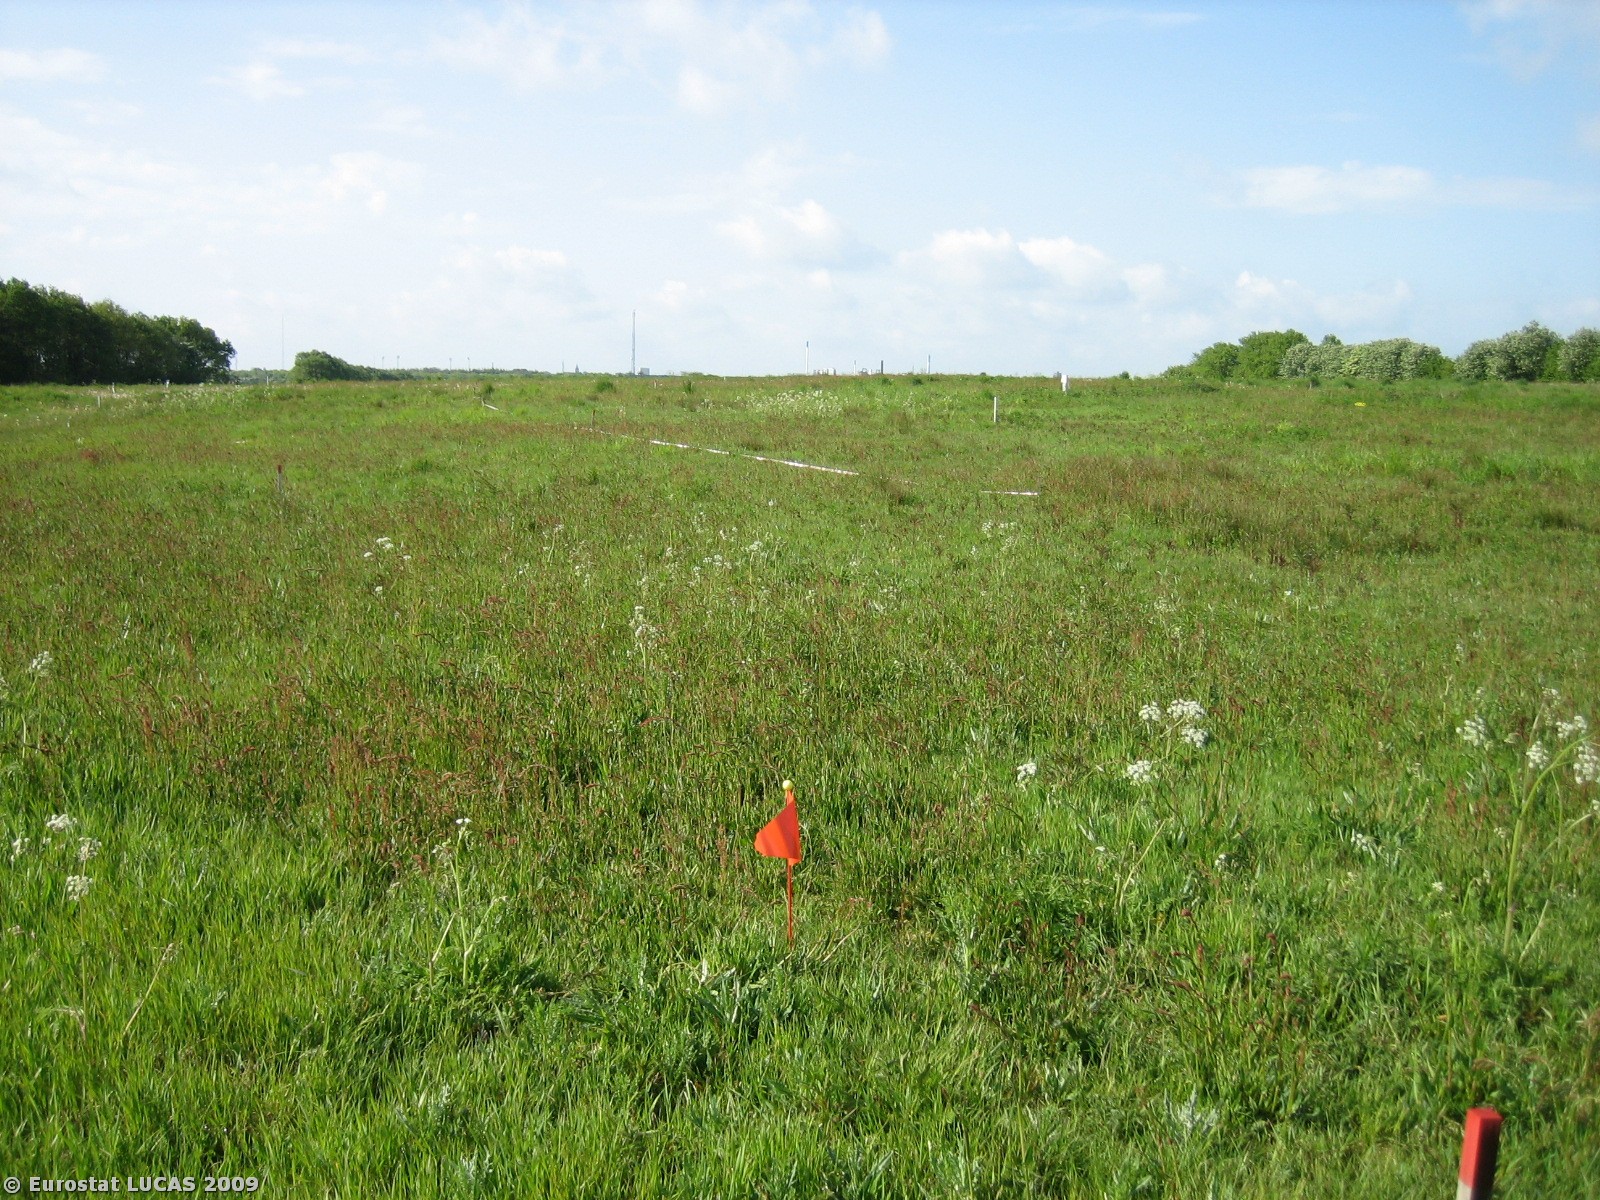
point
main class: Grassland
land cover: Grassland without tree/shrub cover
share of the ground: > 75 %
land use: Construction
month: May
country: DK
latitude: 56.1658
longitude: 8.9866
